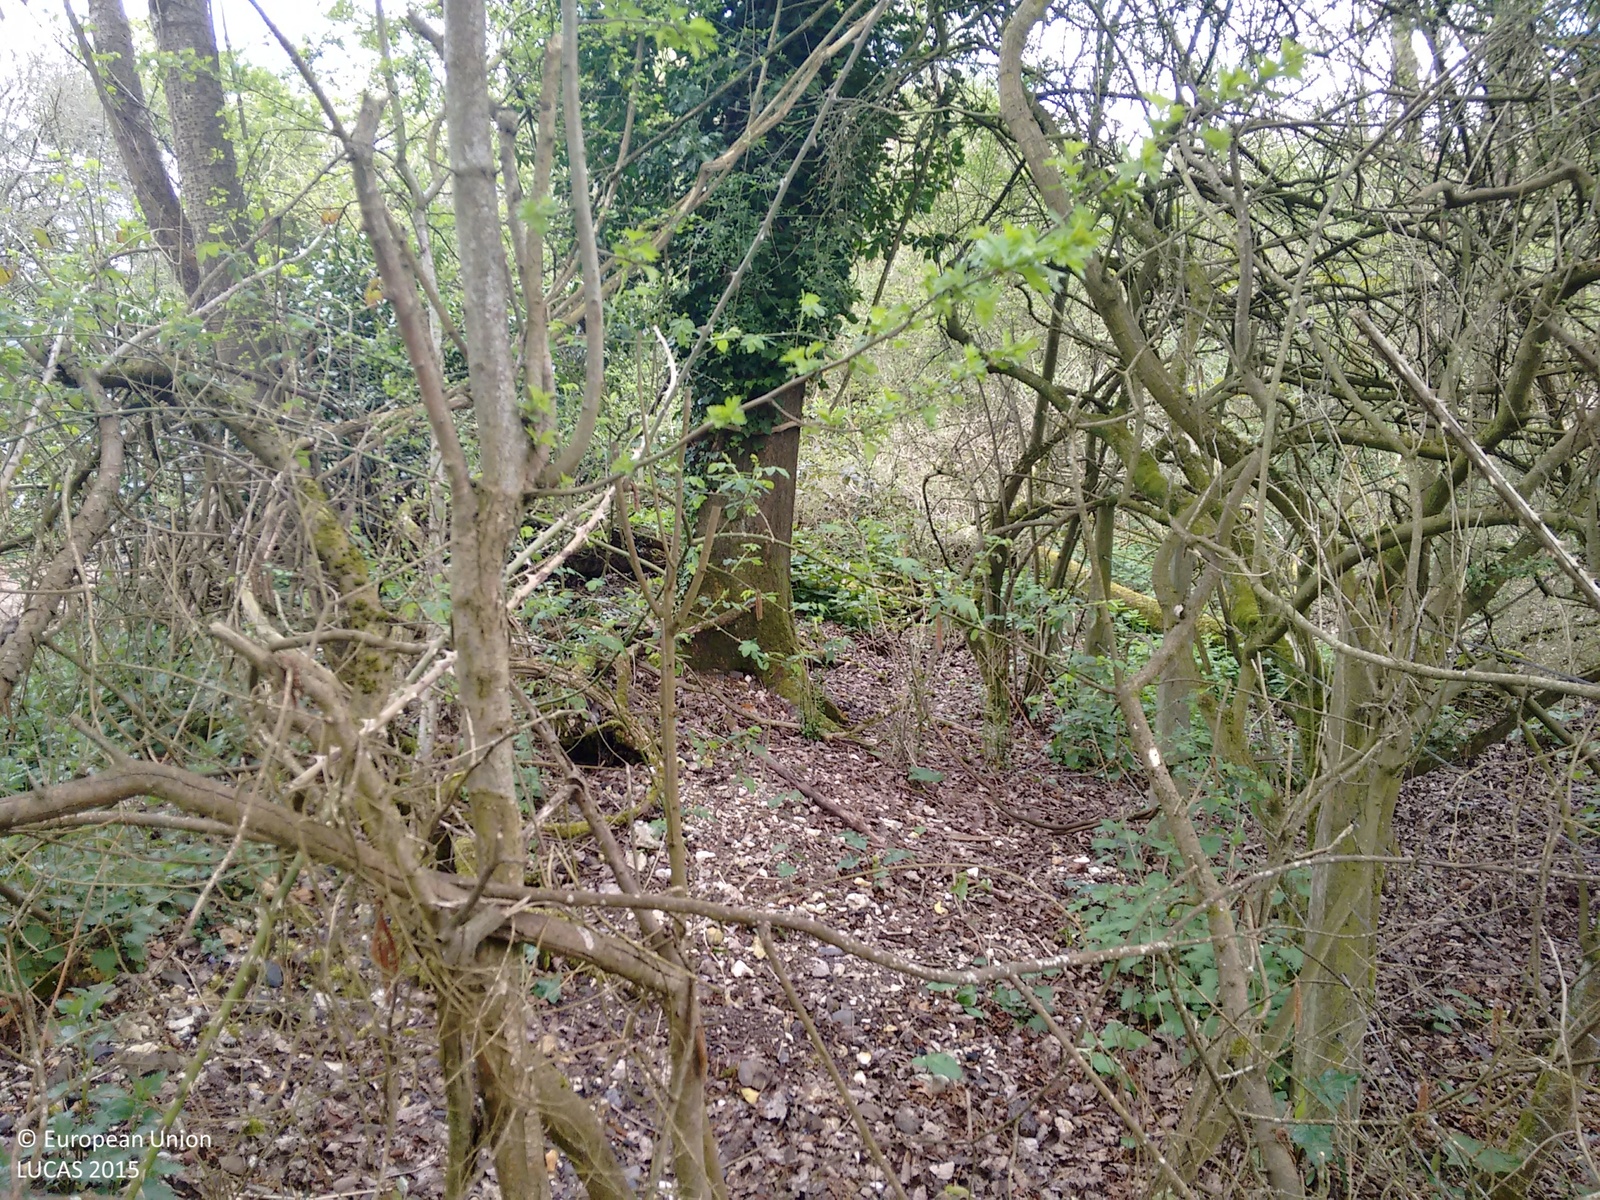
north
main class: Woodland
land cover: Broadleaved woodland
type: mesophytic deciduous forest
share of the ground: > 75 %
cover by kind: broadleaved forest trees 100 %
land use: Semi-natural and natural areas not in use
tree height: > 5 m
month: April
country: GB
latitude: 51.1088
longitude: -1.4918
